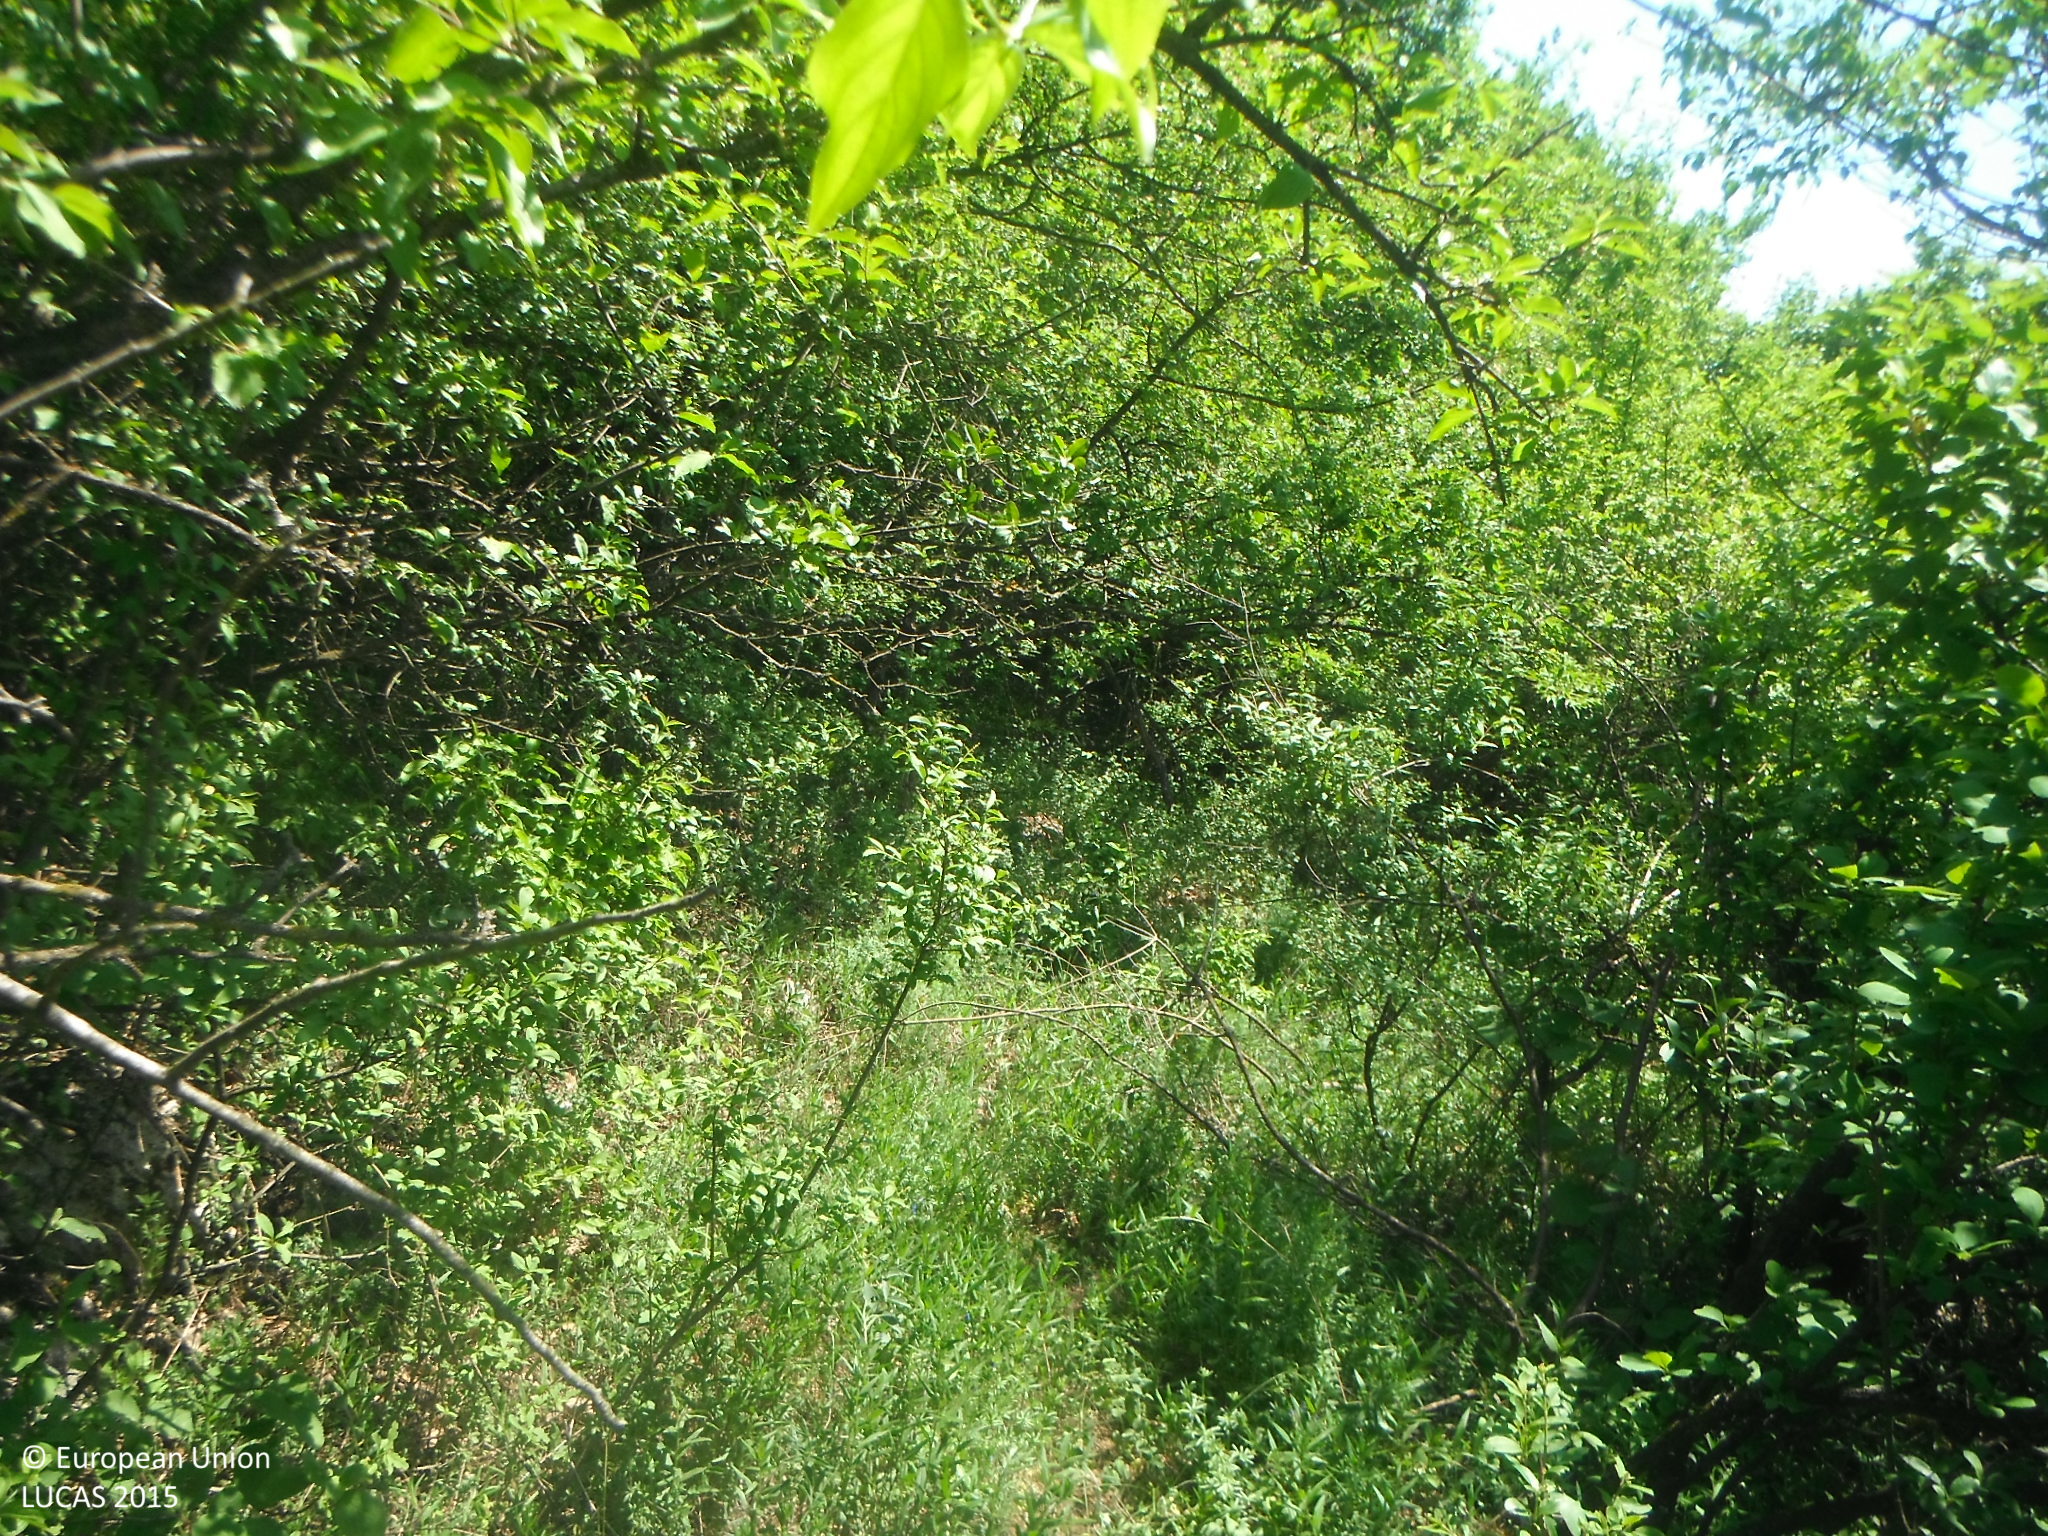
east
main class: Woodland
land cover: Broadleaved woodland
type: mesophytic deciduous forest
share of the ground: 10 - 25 %
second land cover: Shrubland without tree cover
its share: 50 - 75 %
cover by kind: shrubs 60 %, broadleaved forest trees 25 %, herbaceous plants 15 %
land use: Semi-natural and natural areas not in use
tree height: > 5 m
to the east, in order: Broadleaved woodland; Shrubland without tree cover; Broadleaved woodland; Shrubland with sparse tree cover; Tracks; Shrubland with sparse tree cover; Tracks; Shrubland with sparse tree cover
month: May
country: SK
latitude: 48.6247
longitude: 20.9071
